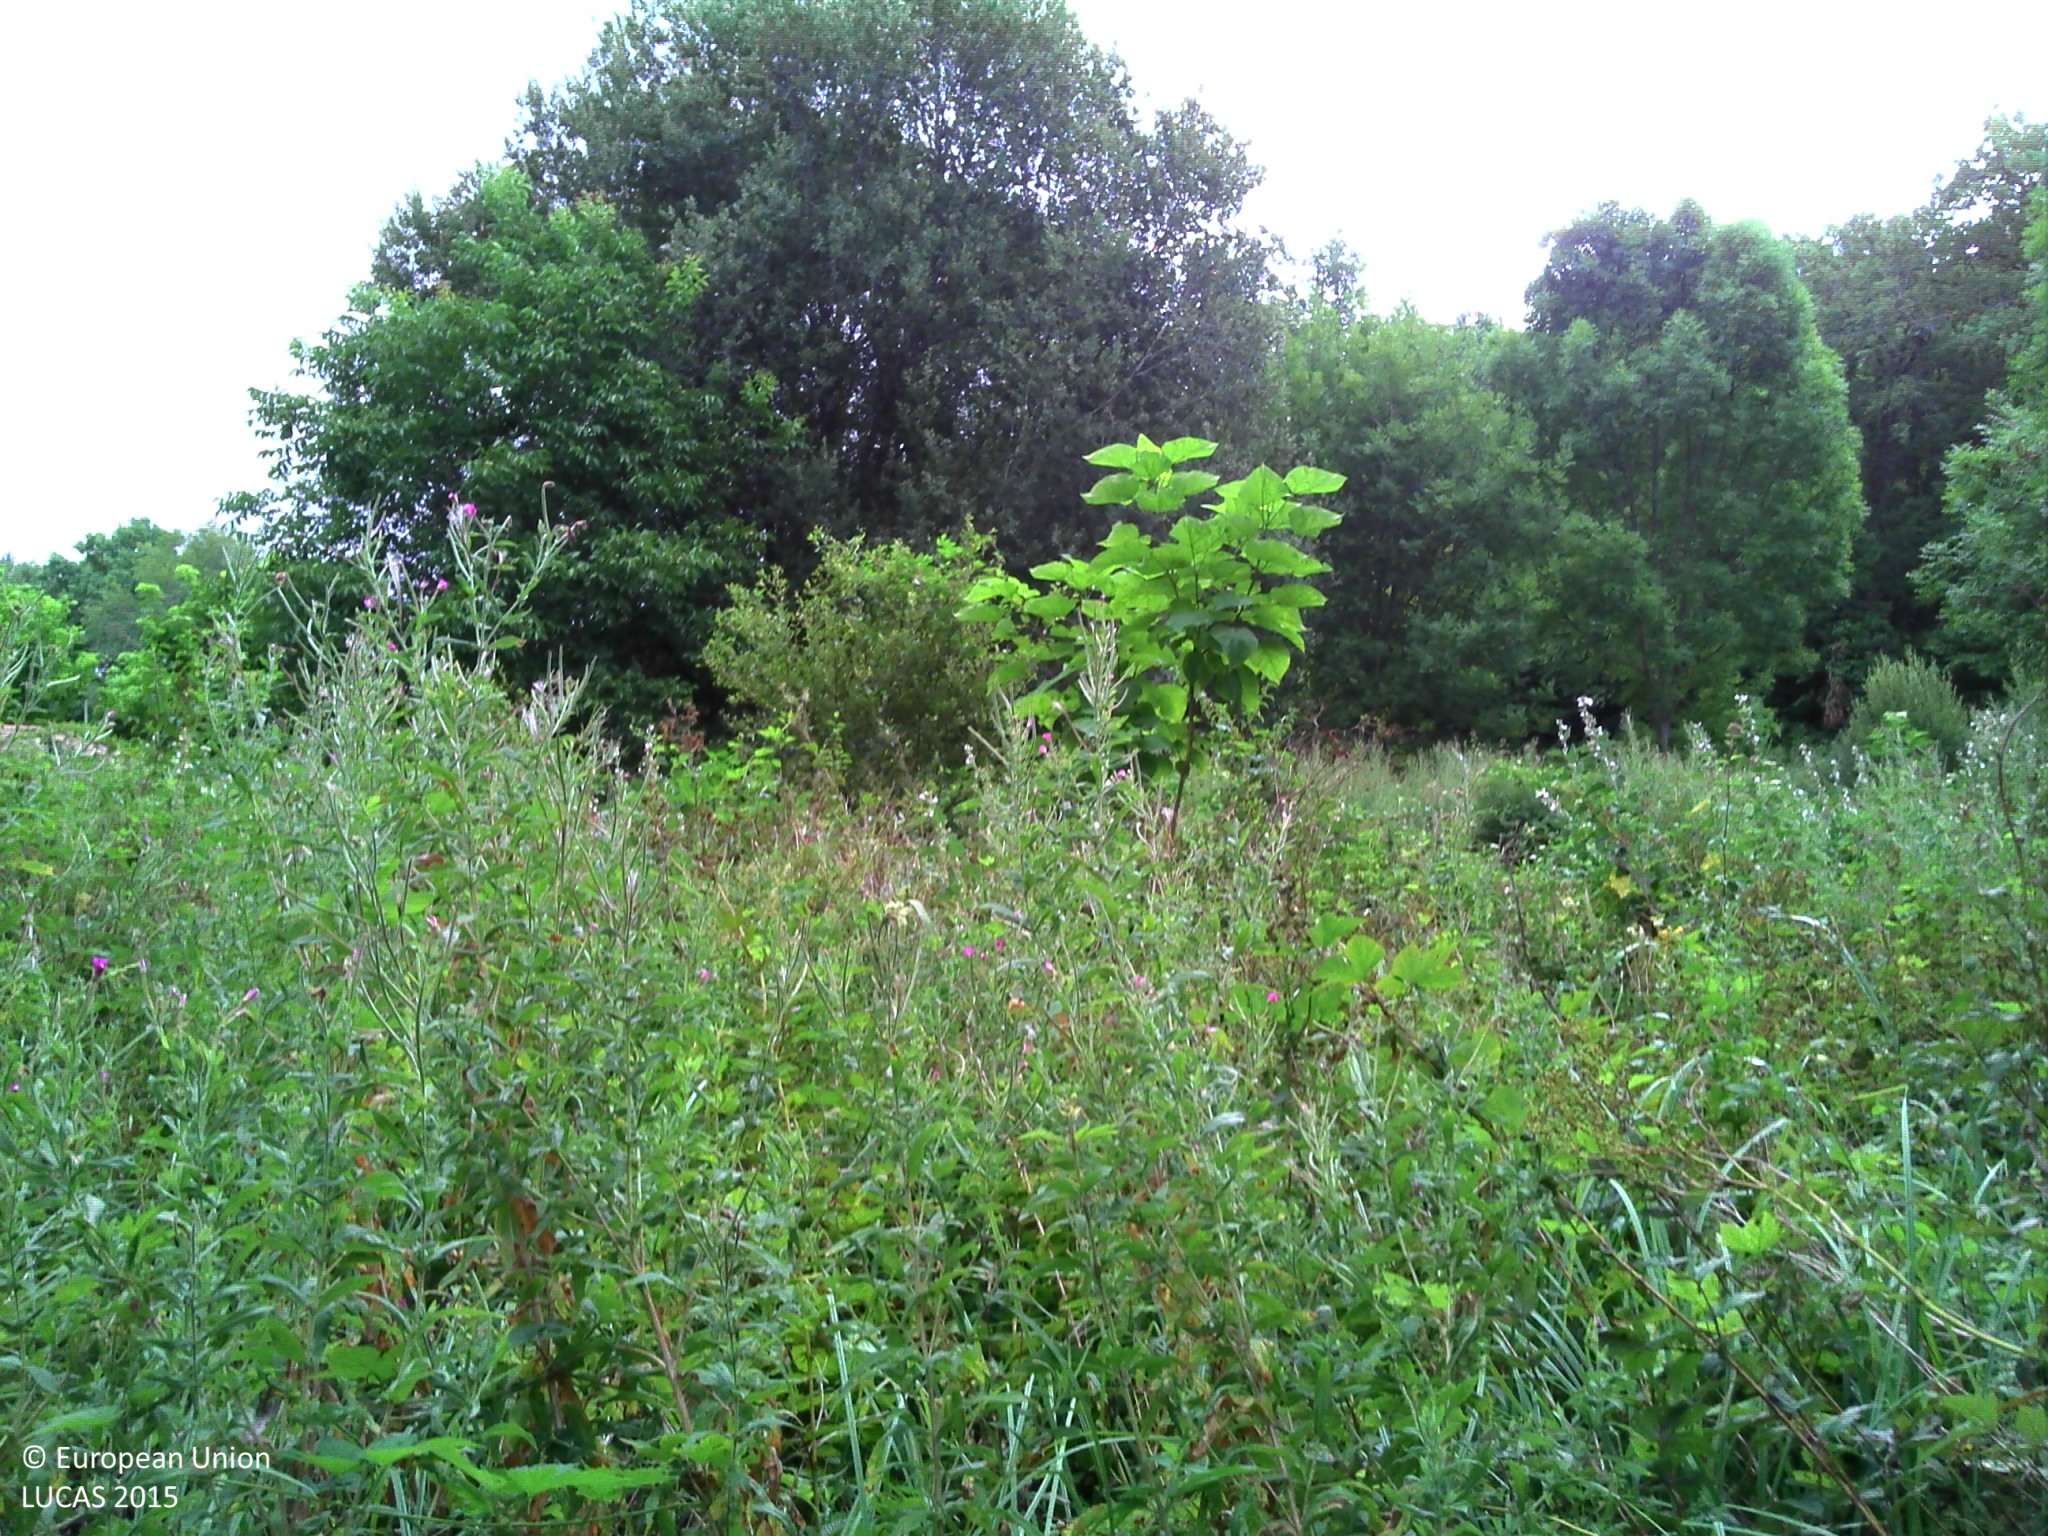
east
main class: Grassland
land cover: Spontaneously vegetated surfaces
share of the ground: > 75 %
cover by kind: herbaceous plants 95 %, shrubs 5 %
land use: Semi-natural and natural areas not in use
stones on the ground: < 10 %
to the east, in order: Spontaneously vegetated surfaces; Broadleaved woodland; Grass margins; Paved roads, cycling and walking lanes; Grass margins; Electric lines; Grass margins; Paved roads, cycling and walking lanes; Grass margins; Ditches and canals; Grass margins; Broadleaved woodland
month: July
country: FR
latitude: 44.9369
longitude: 0.7793
